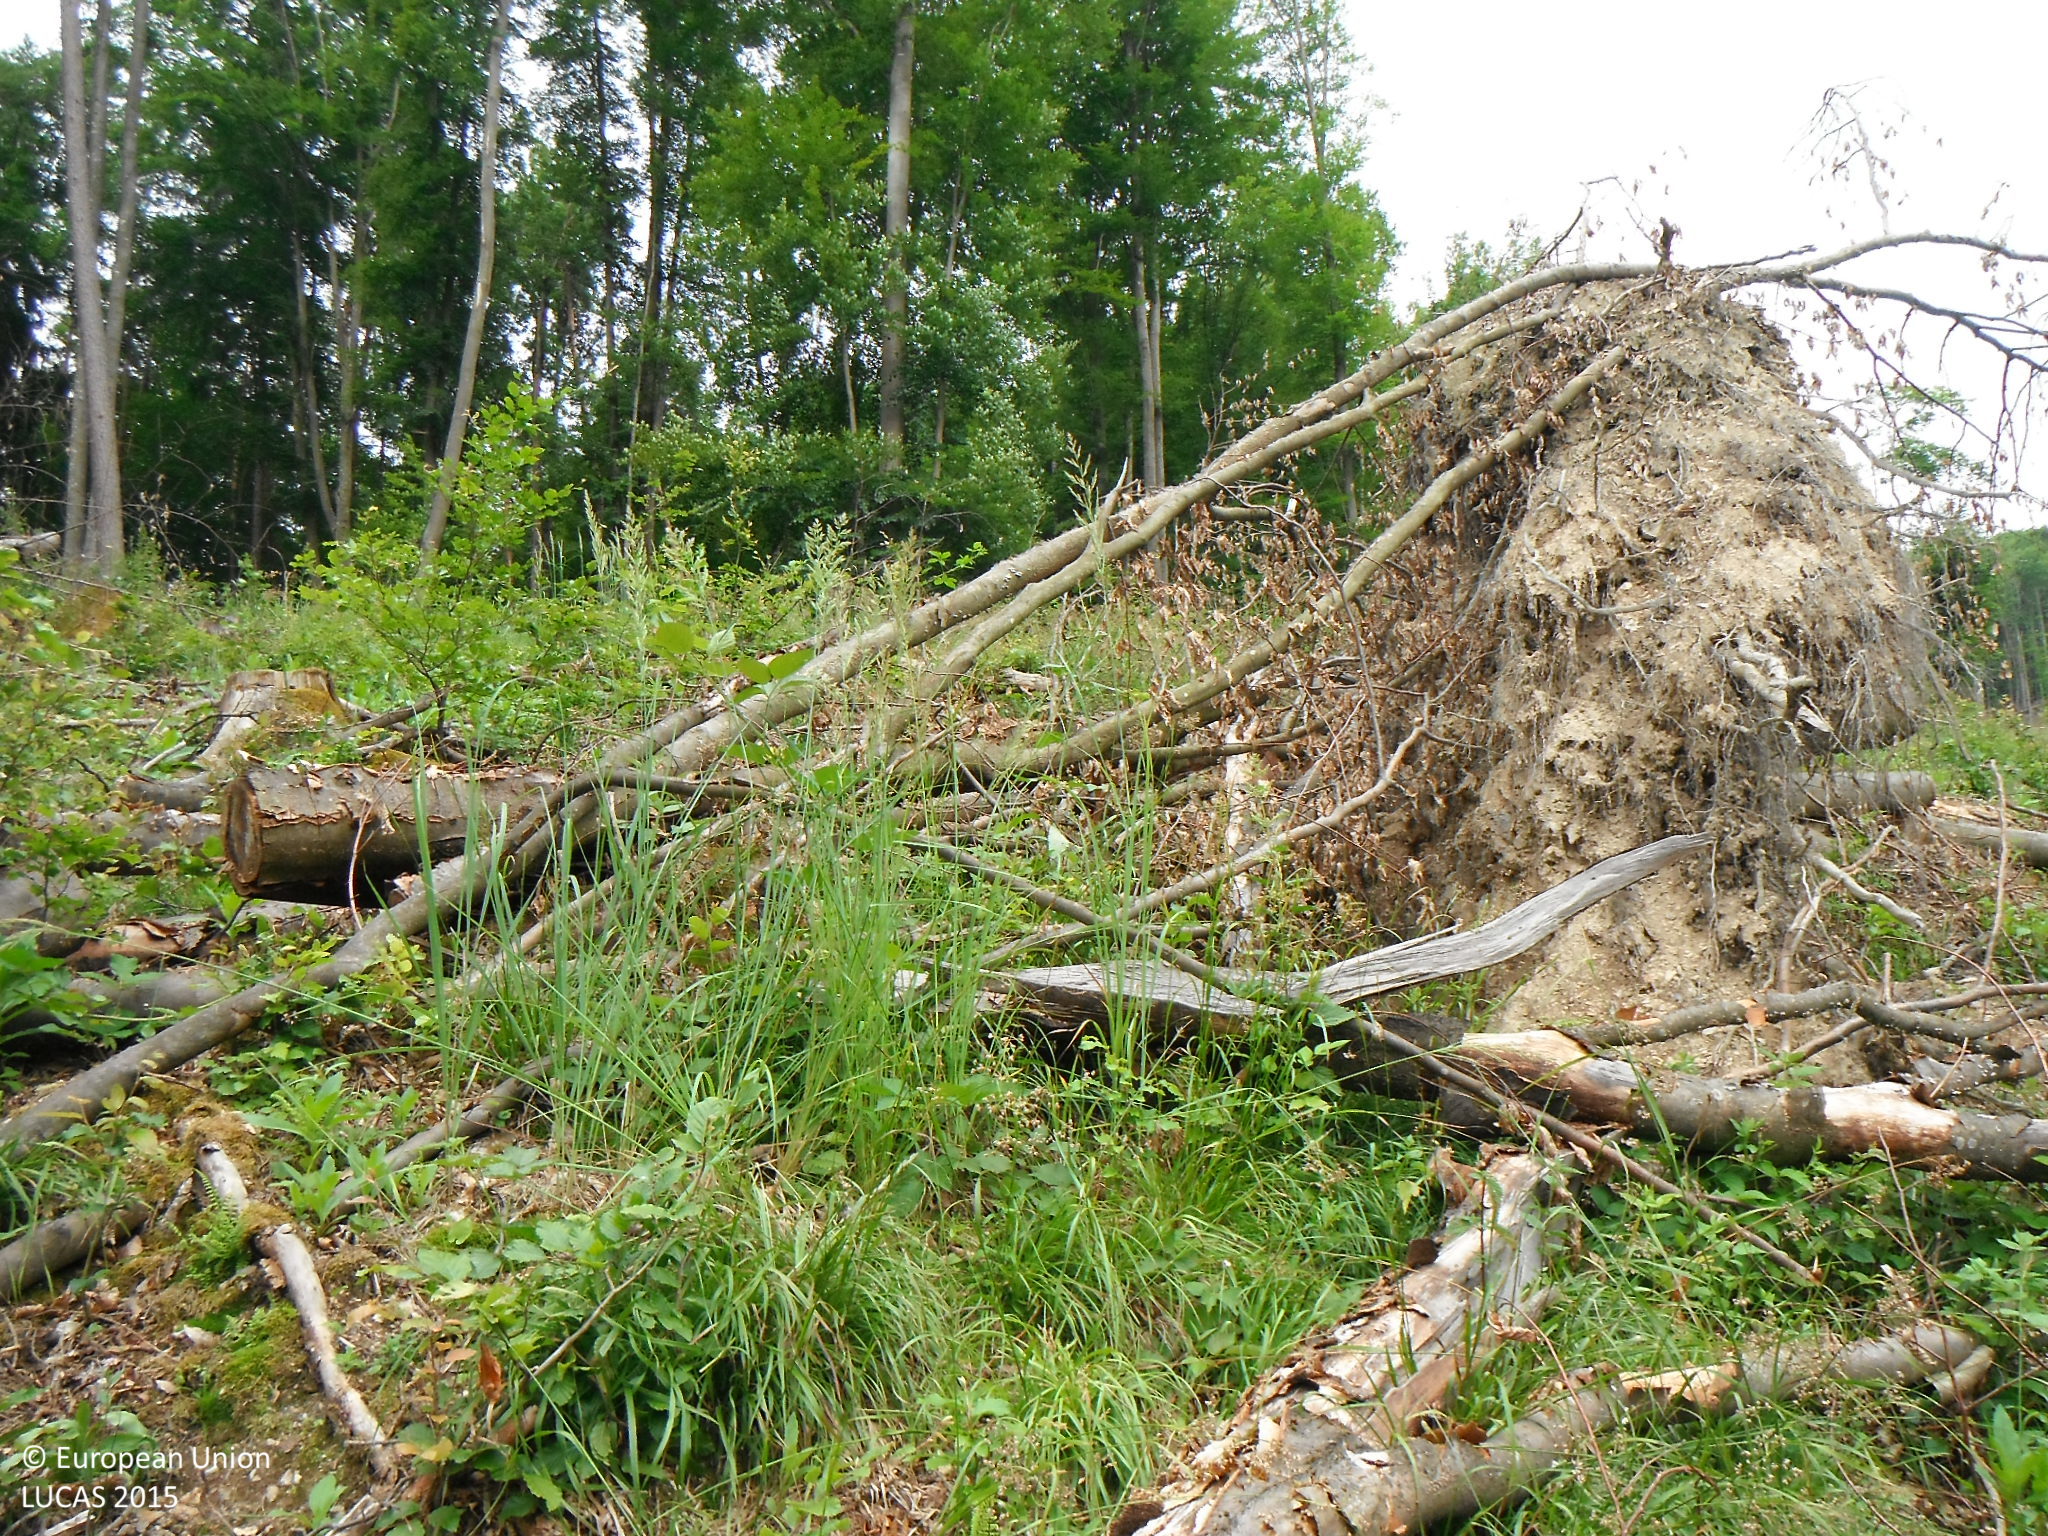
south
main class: Grassland
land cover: Spontaneously vegetated surfaces
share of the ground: 50 - 75 %
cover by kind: herbaceous plants 55 %, unconsolidated bare surface 10 %, shrubs 5 %
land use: Forestry
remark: Clear cut
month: June
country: SK
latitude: 48.5566
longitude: 20.0974
